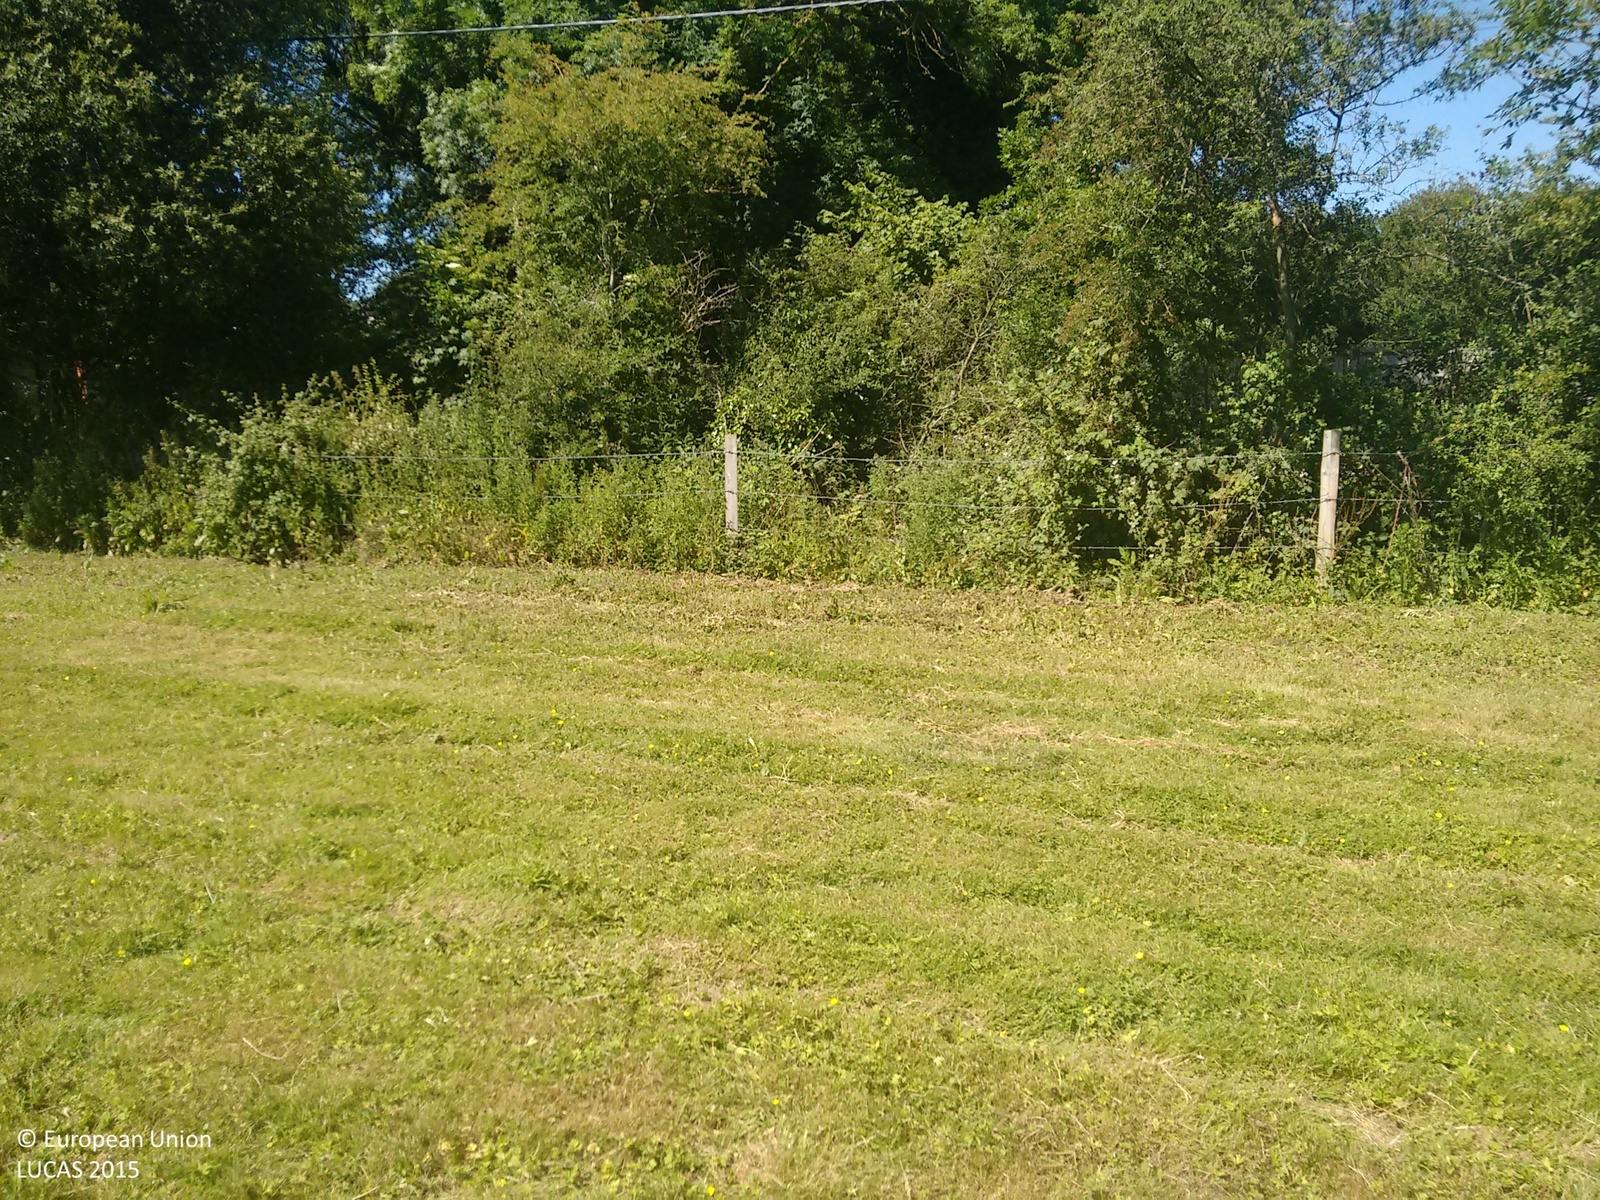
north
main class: Grassland
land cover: Grassland without tree/shrub cover
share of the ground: > 75 %
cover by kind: herbaceous plants 100 %
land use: Agriculture (excluding fallow land and kitchen gardens)
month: June
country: GB
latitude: 50.8554
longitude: -0.5365
